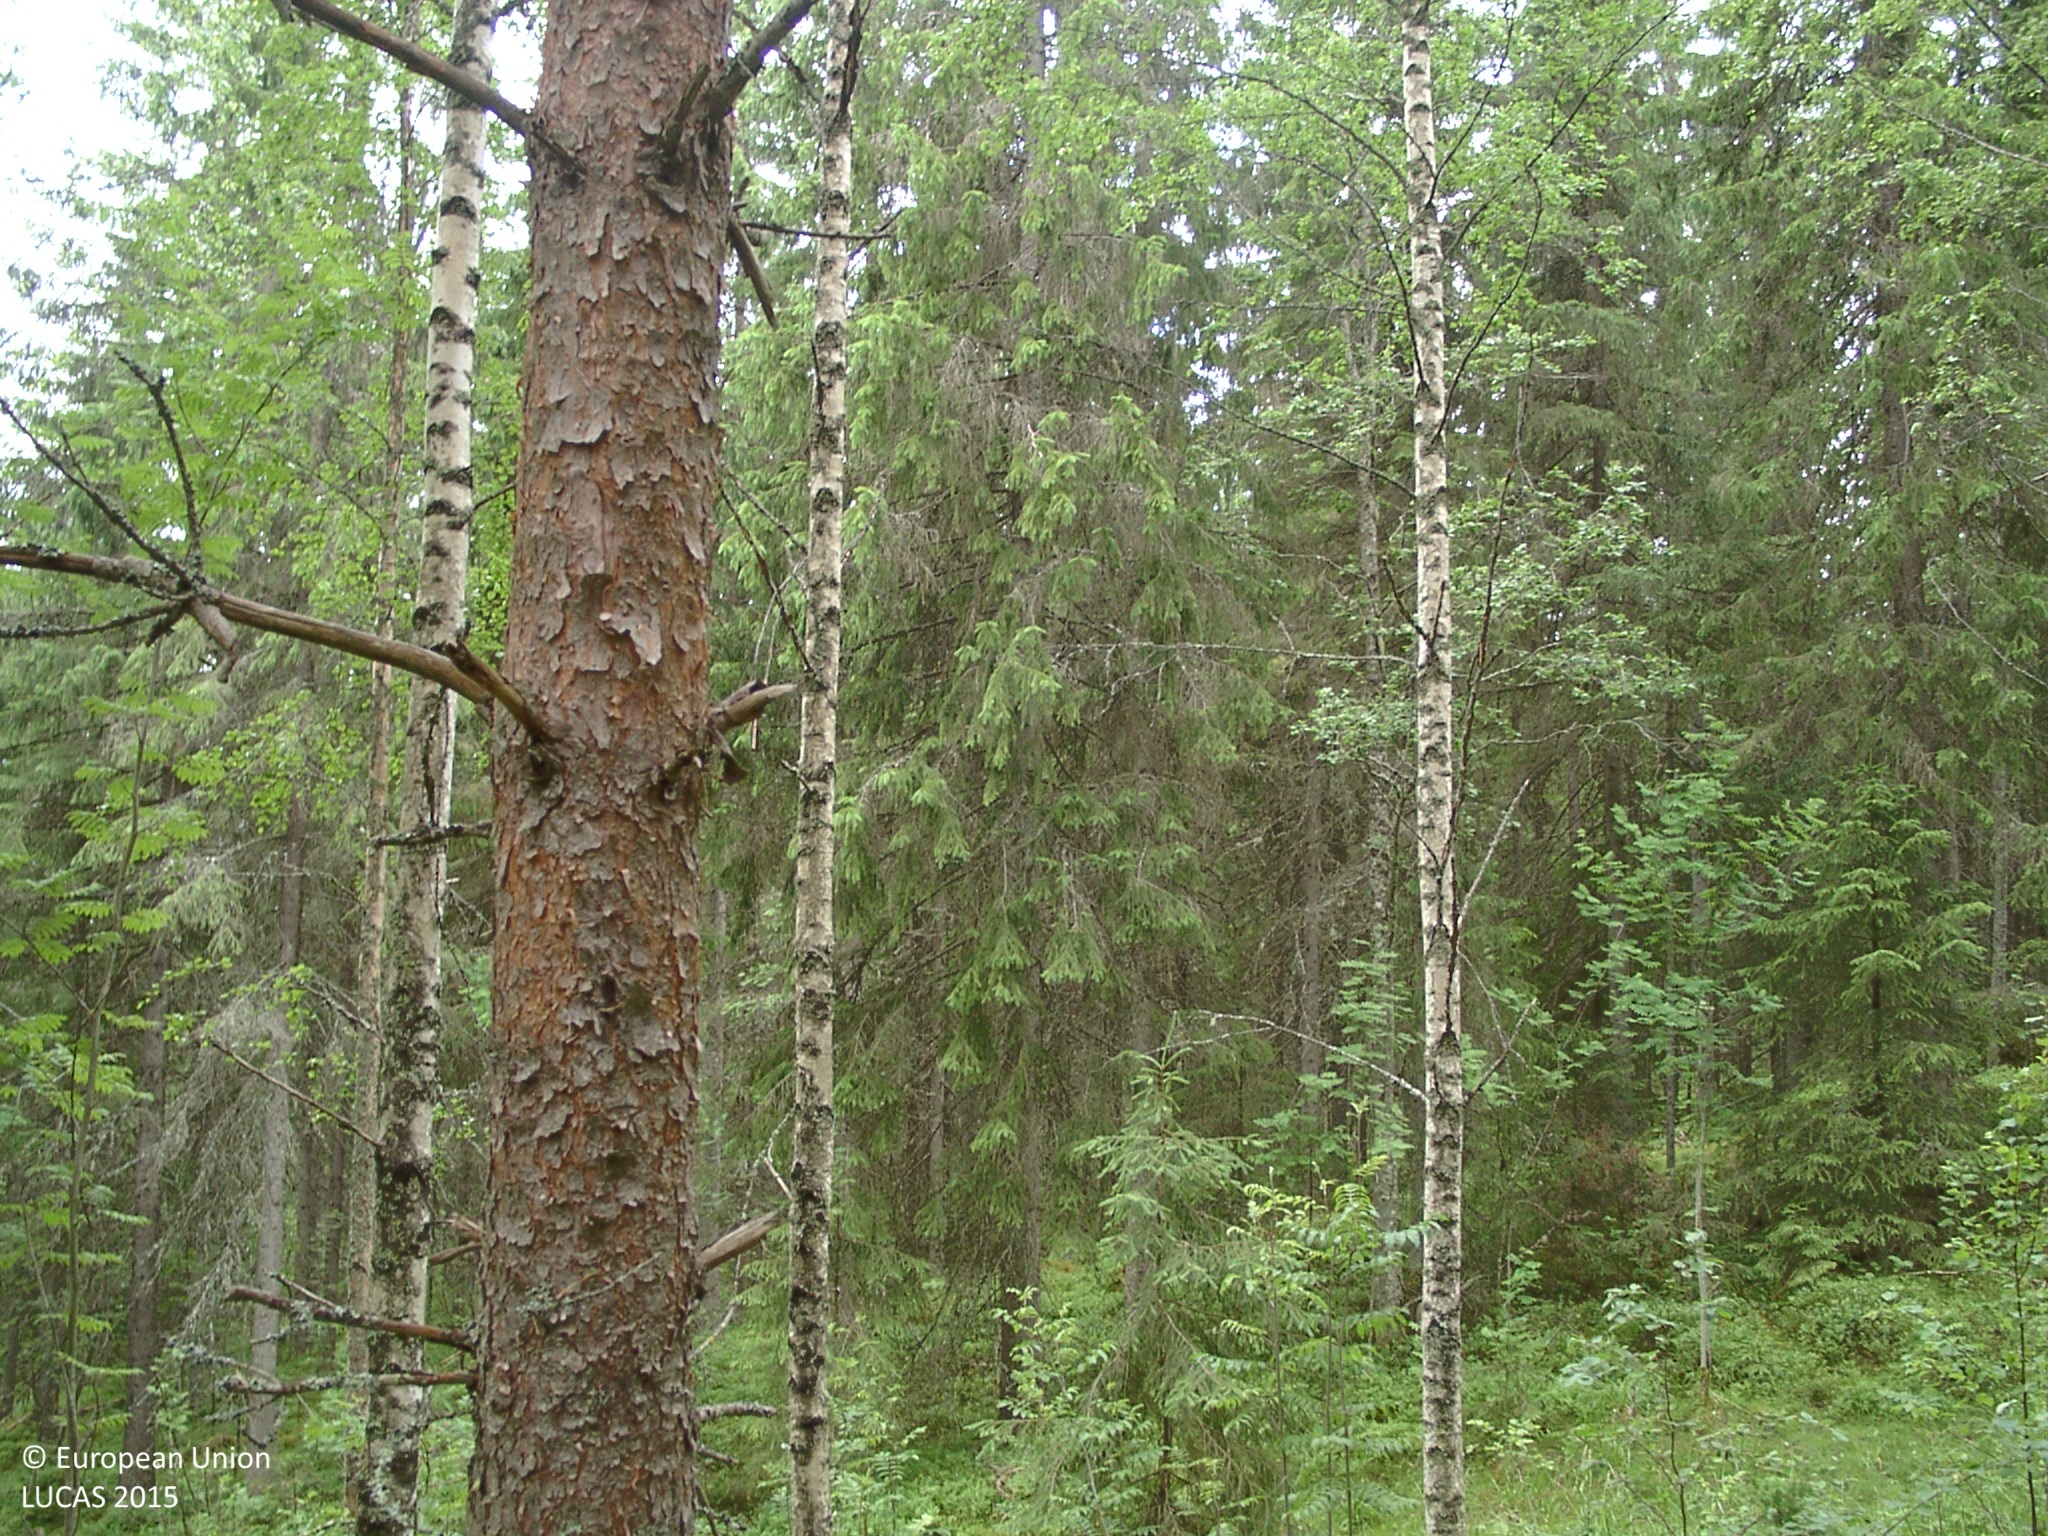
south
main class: Woodland
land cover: Pine dominated mixed woodland
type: boreal forest
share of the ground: 50 - 75 %
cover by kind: coniferous forest trees 45 %, broadleaved forest trees 25 %, shrubs 15 %, herbaceous plants 15 %
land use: Forestry
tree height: > 5 m
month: July
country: FI
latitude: 62.1134
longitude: 25.3481
